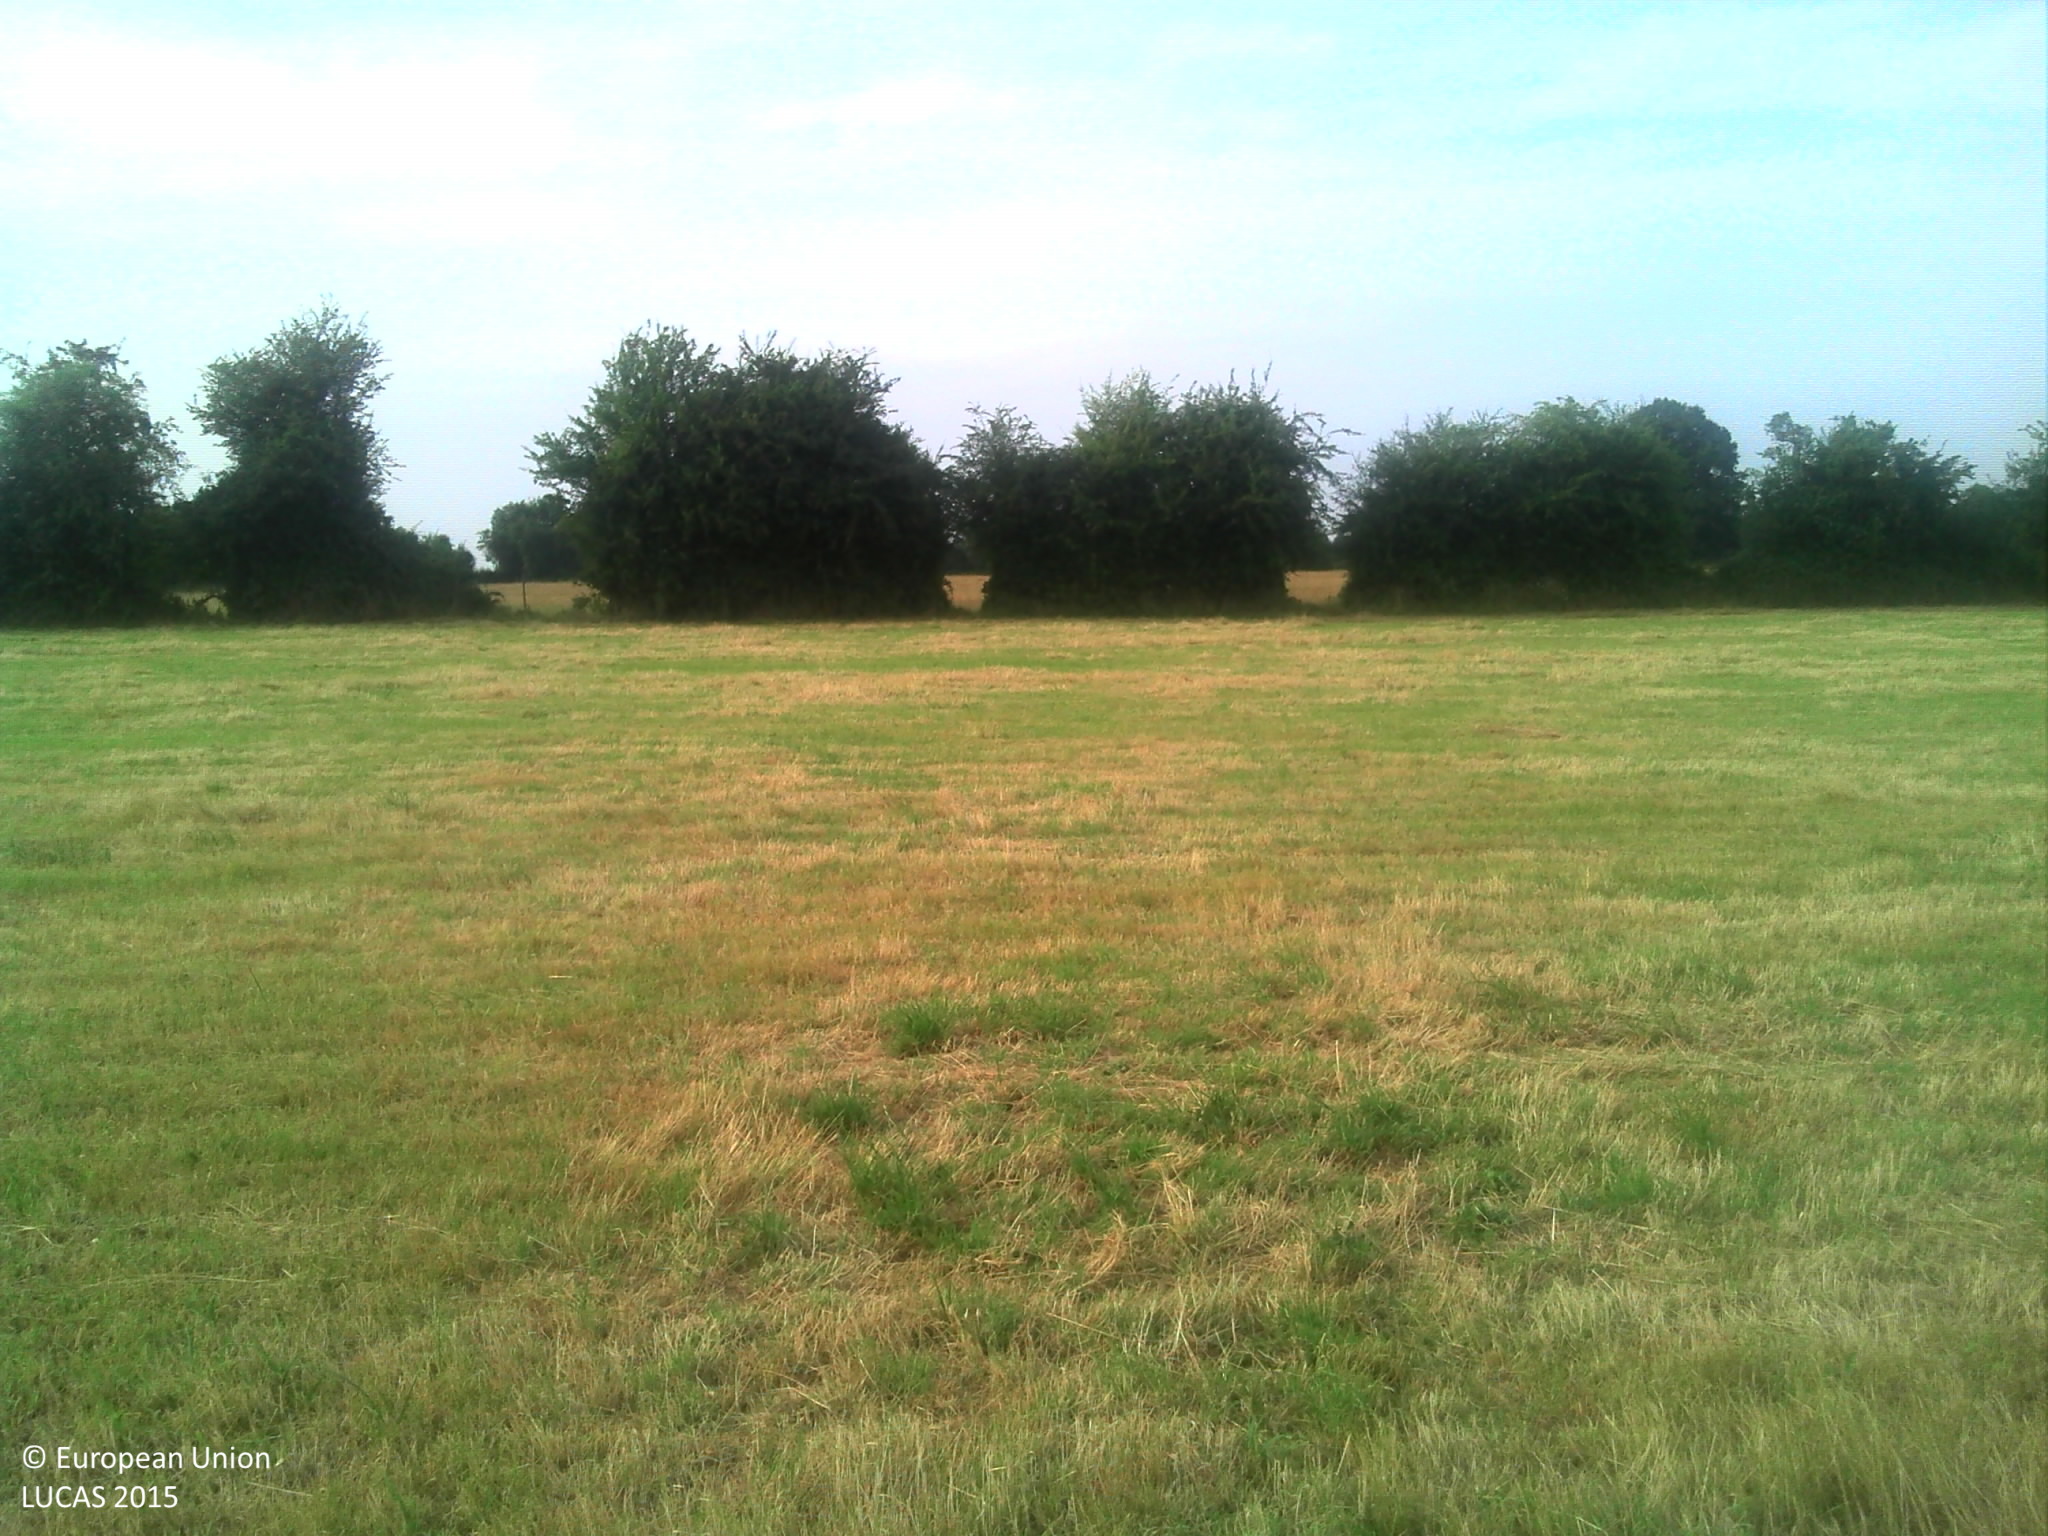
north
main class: Grassland
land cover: Grassland without tree/shrub cover
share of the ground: > 75 %
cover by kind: herbaceous plants 100 %
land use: Agriculture (excluding fallow land and kitchen gardens)
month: July
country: FR
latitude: 48.9453
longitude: 0.4019
